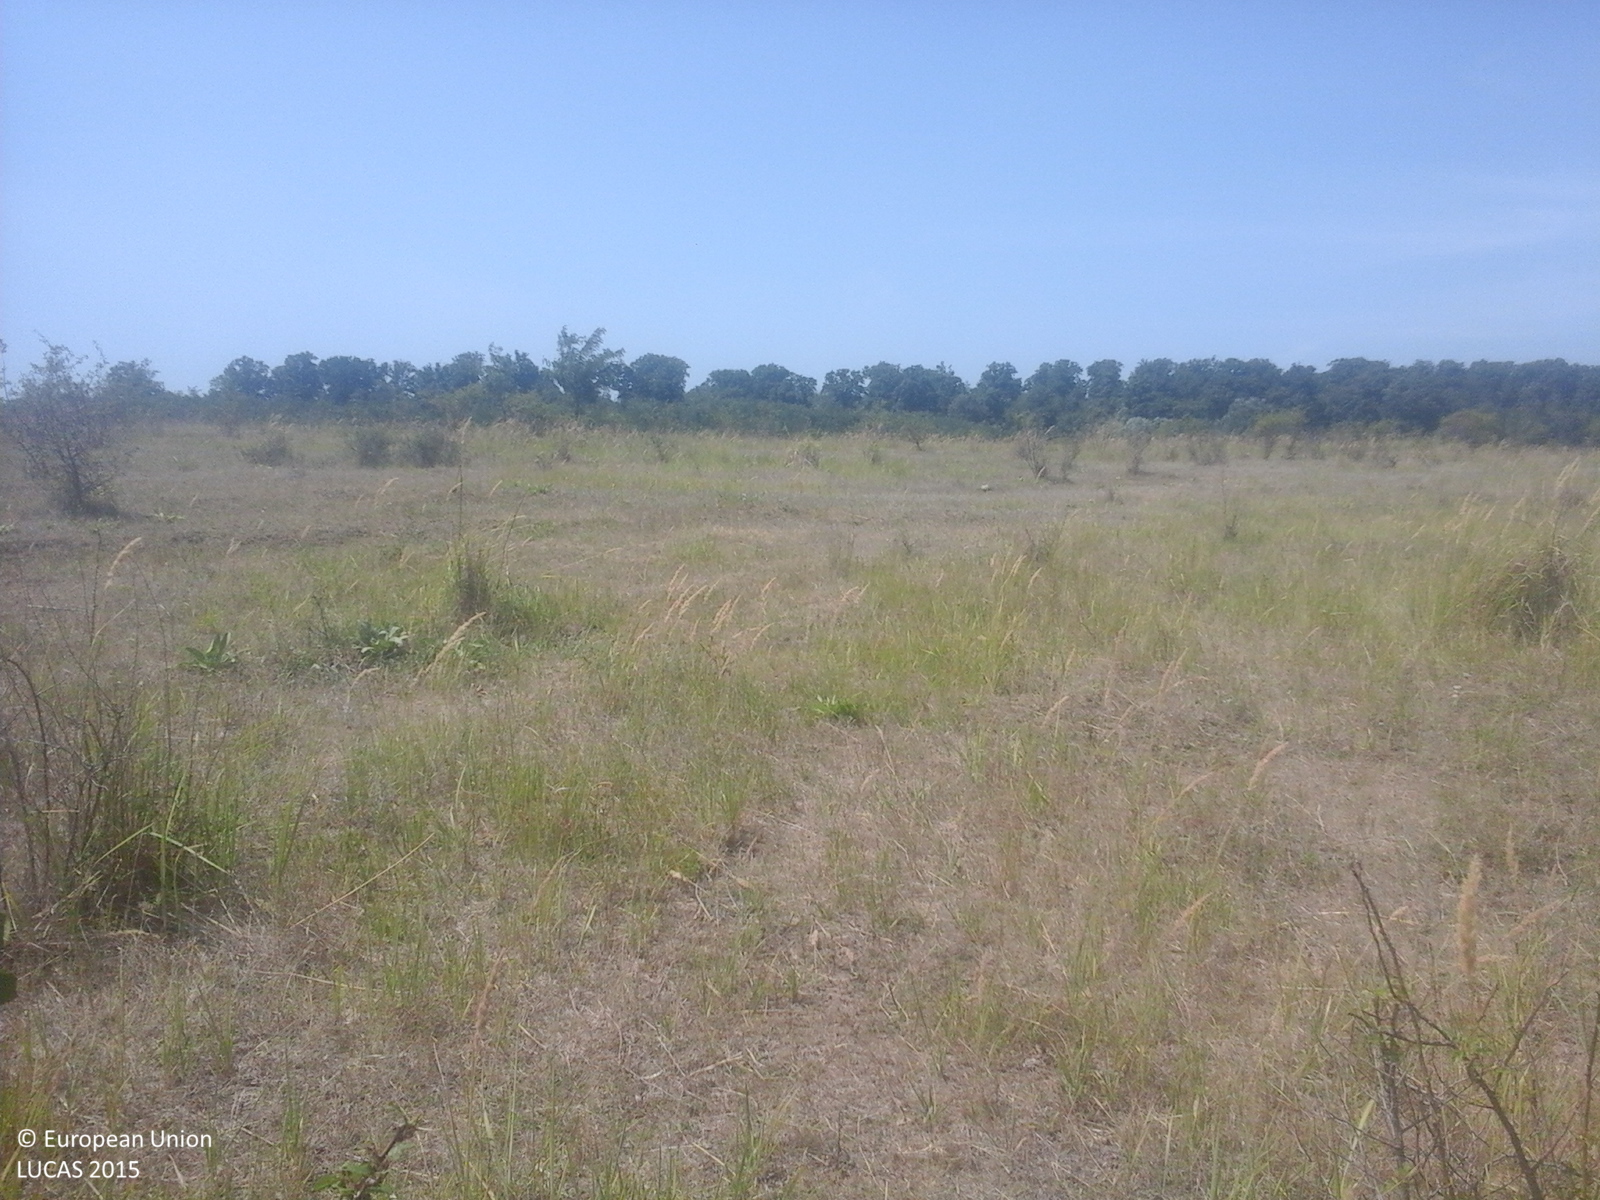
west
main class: Grassland
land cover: Grassland without tree/shrub cover
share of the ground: > 75 %
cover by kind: herbaceous plants 100 %
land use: Agriculture (excluding fallow land and kitchen gardens)
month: July
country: RO
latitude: 46.7054
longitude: 28.0081
